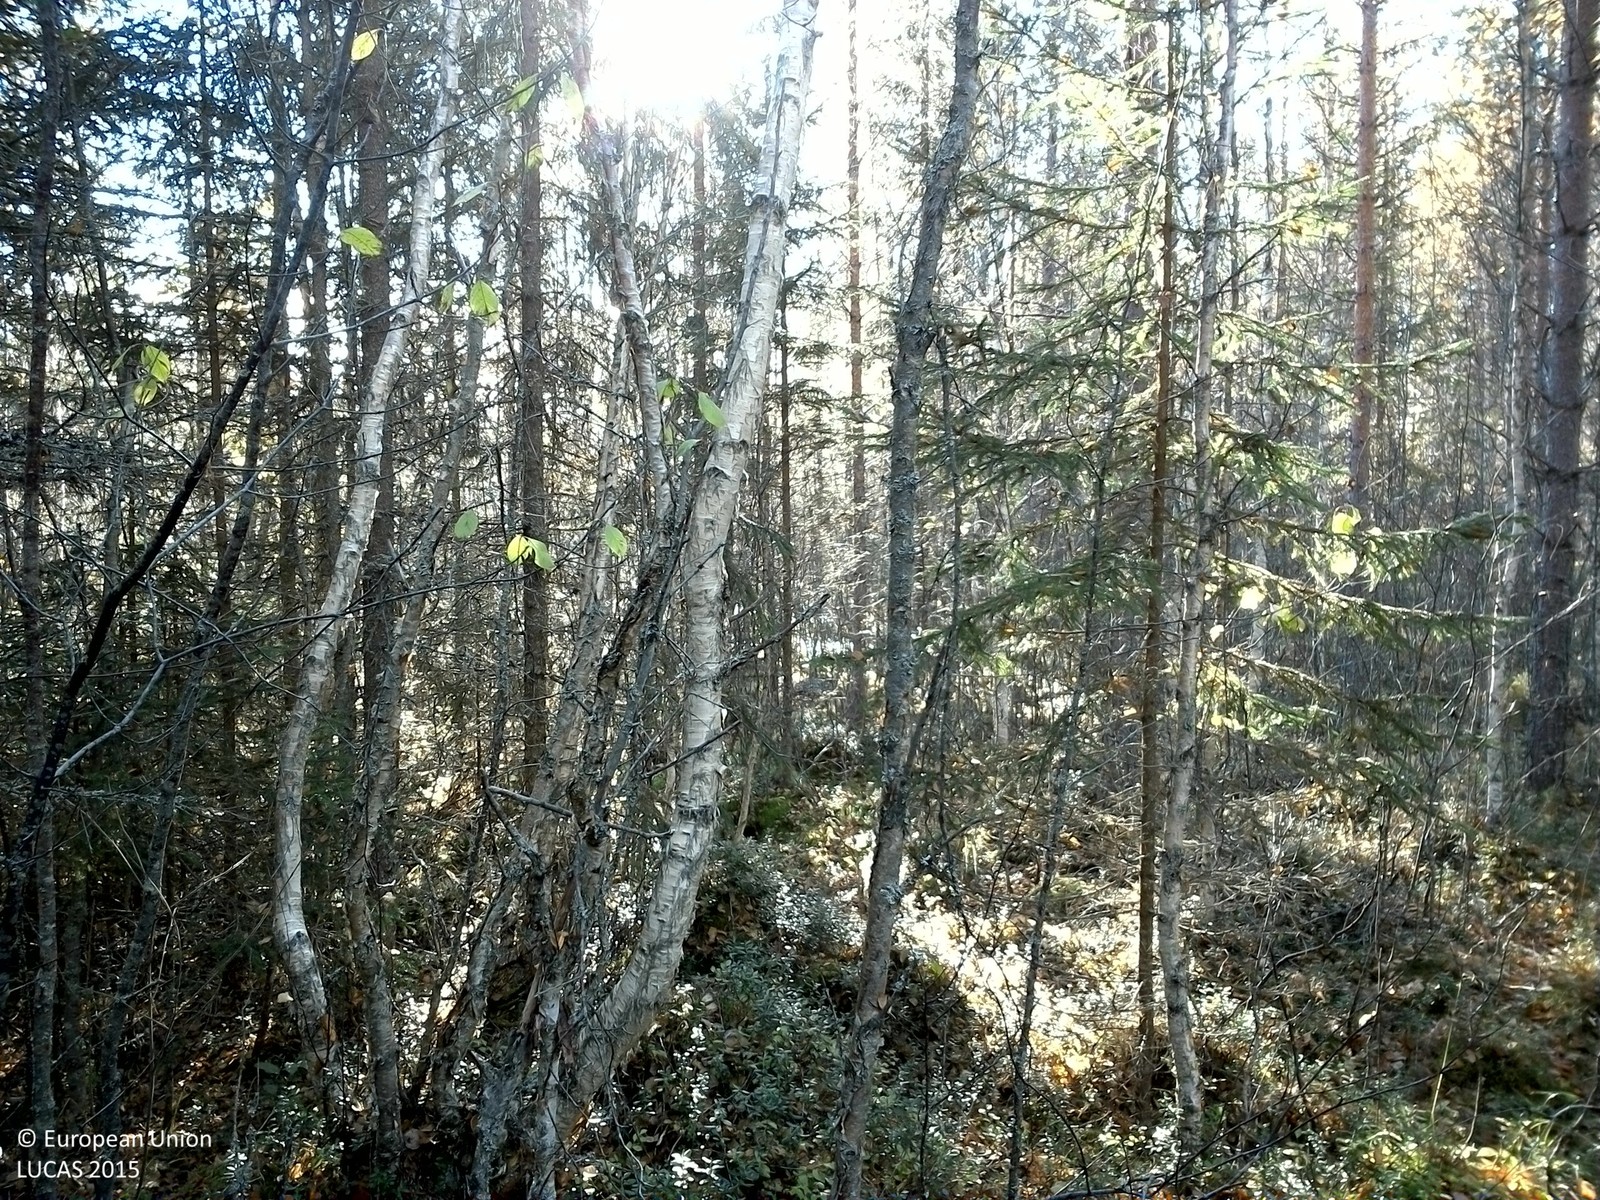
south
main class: Woodland
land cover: Spruce dominated mixed woodland
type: boreal forest
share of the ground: > 75 %
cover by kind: broadleaved forest trees 40 %, coniferous forest trees 35 %, shrubs 15 %, lichens and mosses 10 %
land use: Forestry
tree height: > 5 m
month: October
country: SE
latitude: 61.2112
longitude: 14.9927
